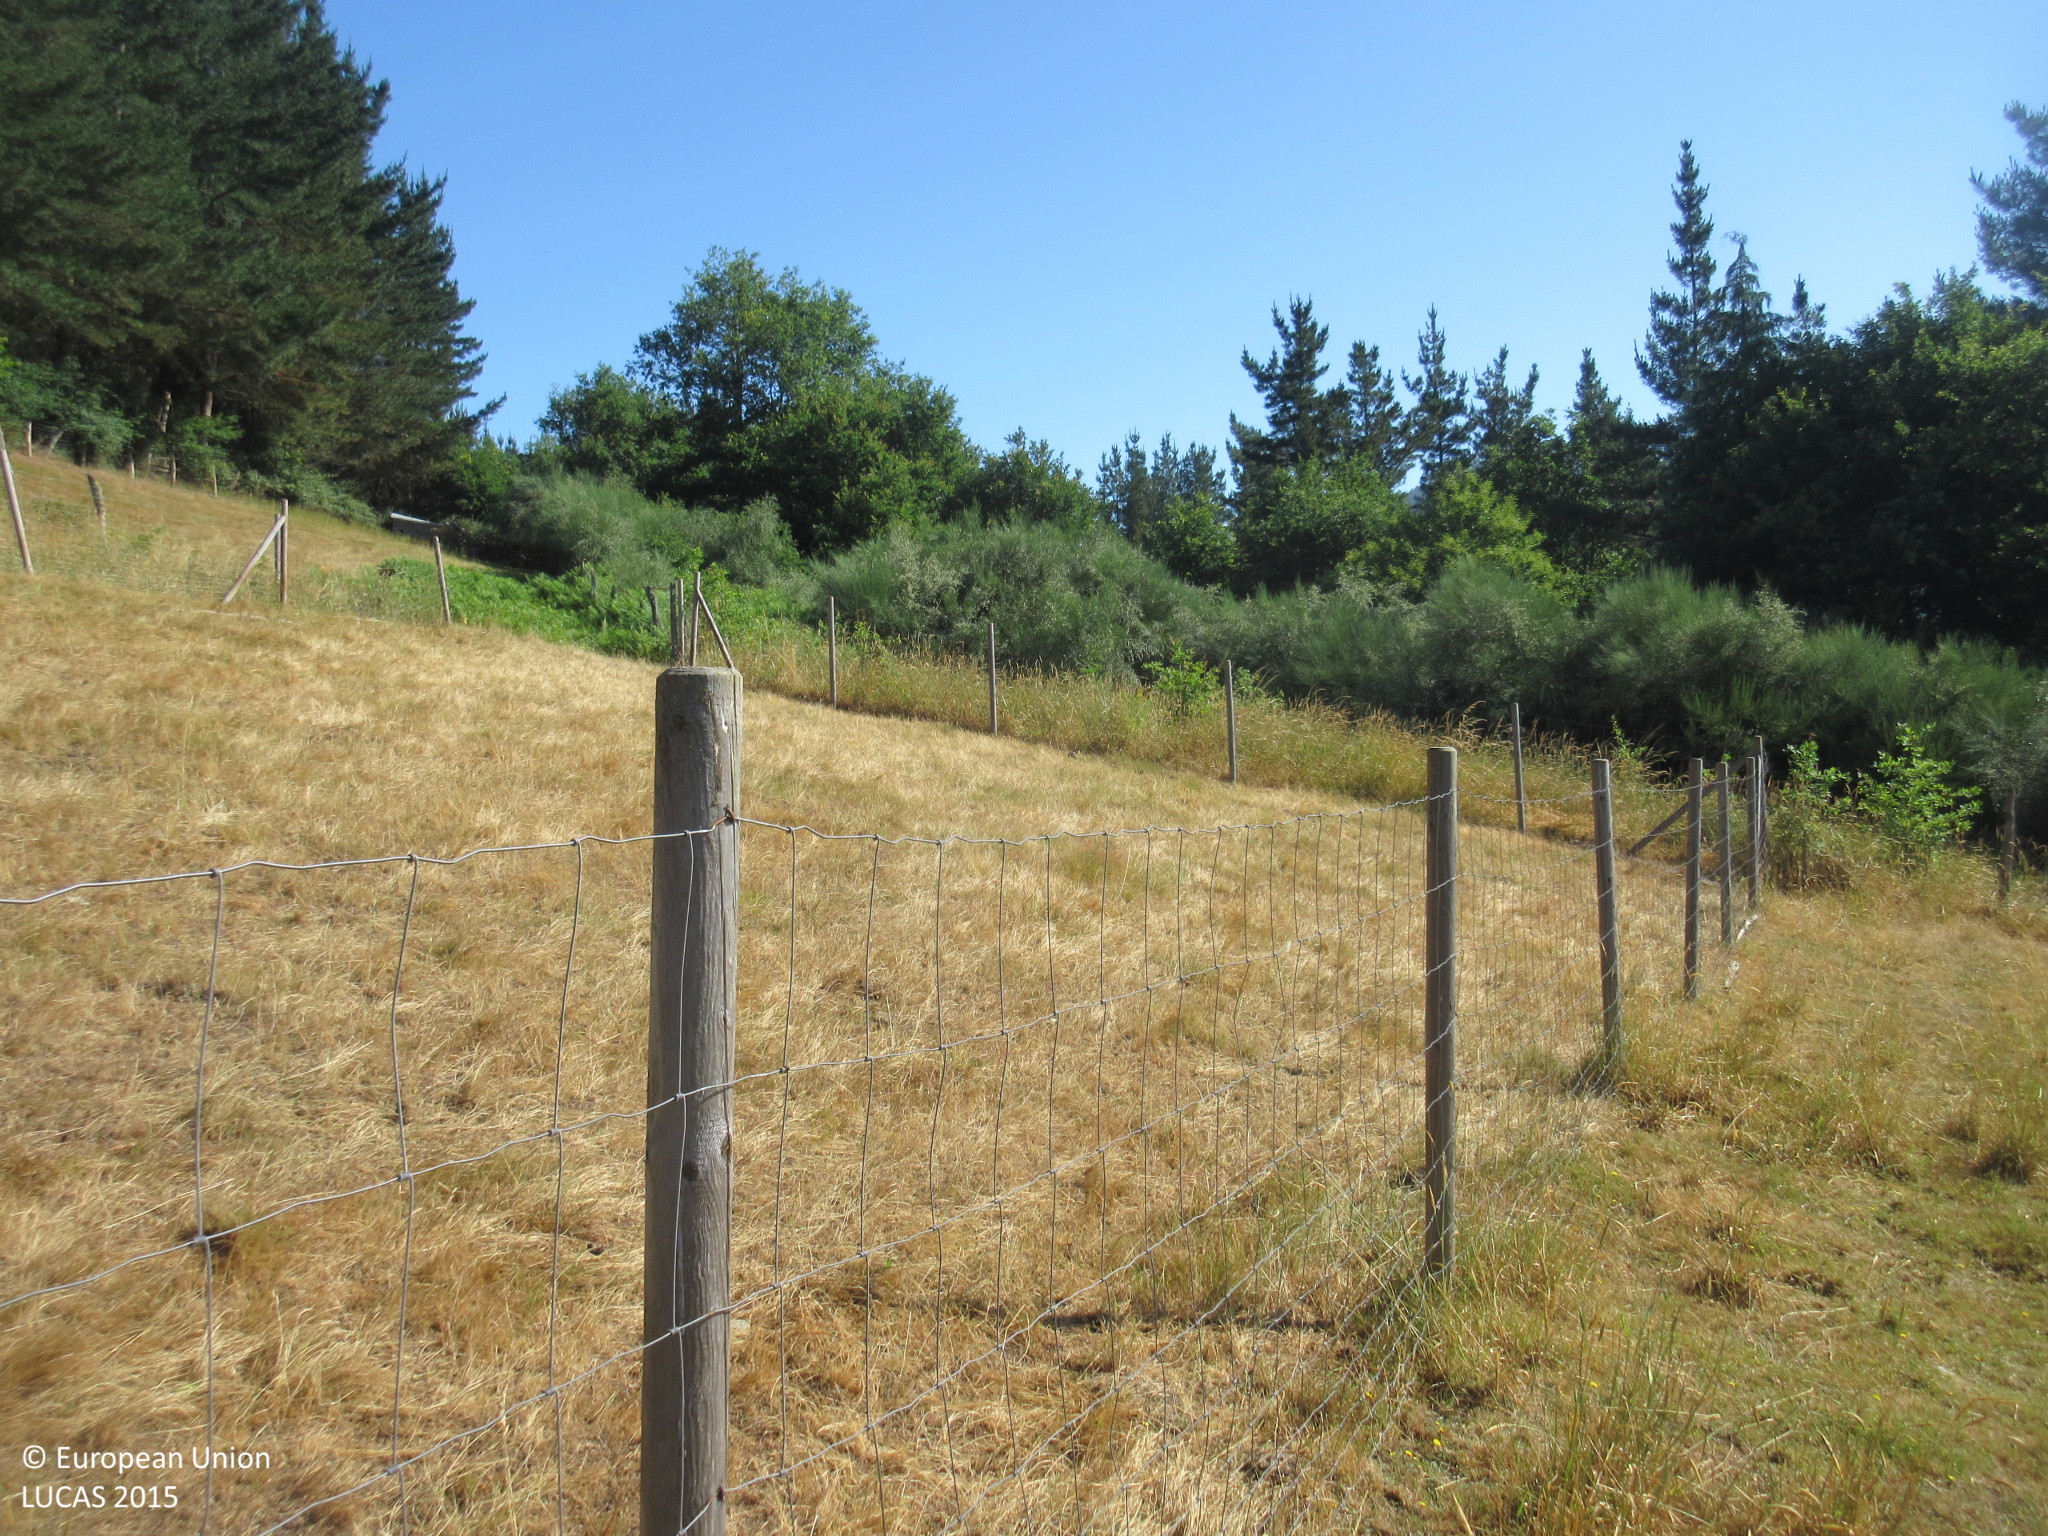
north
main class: Grassland
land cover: Grassland without tree/shrub cover
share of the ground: > 75 %
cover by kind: herbaceous plants 100 %
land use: Agriculture (excluding fallow land and kitchen gardens)
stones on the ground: 10 - 25 %
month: June
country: ES
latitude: 43.0956
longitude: -7.0307
